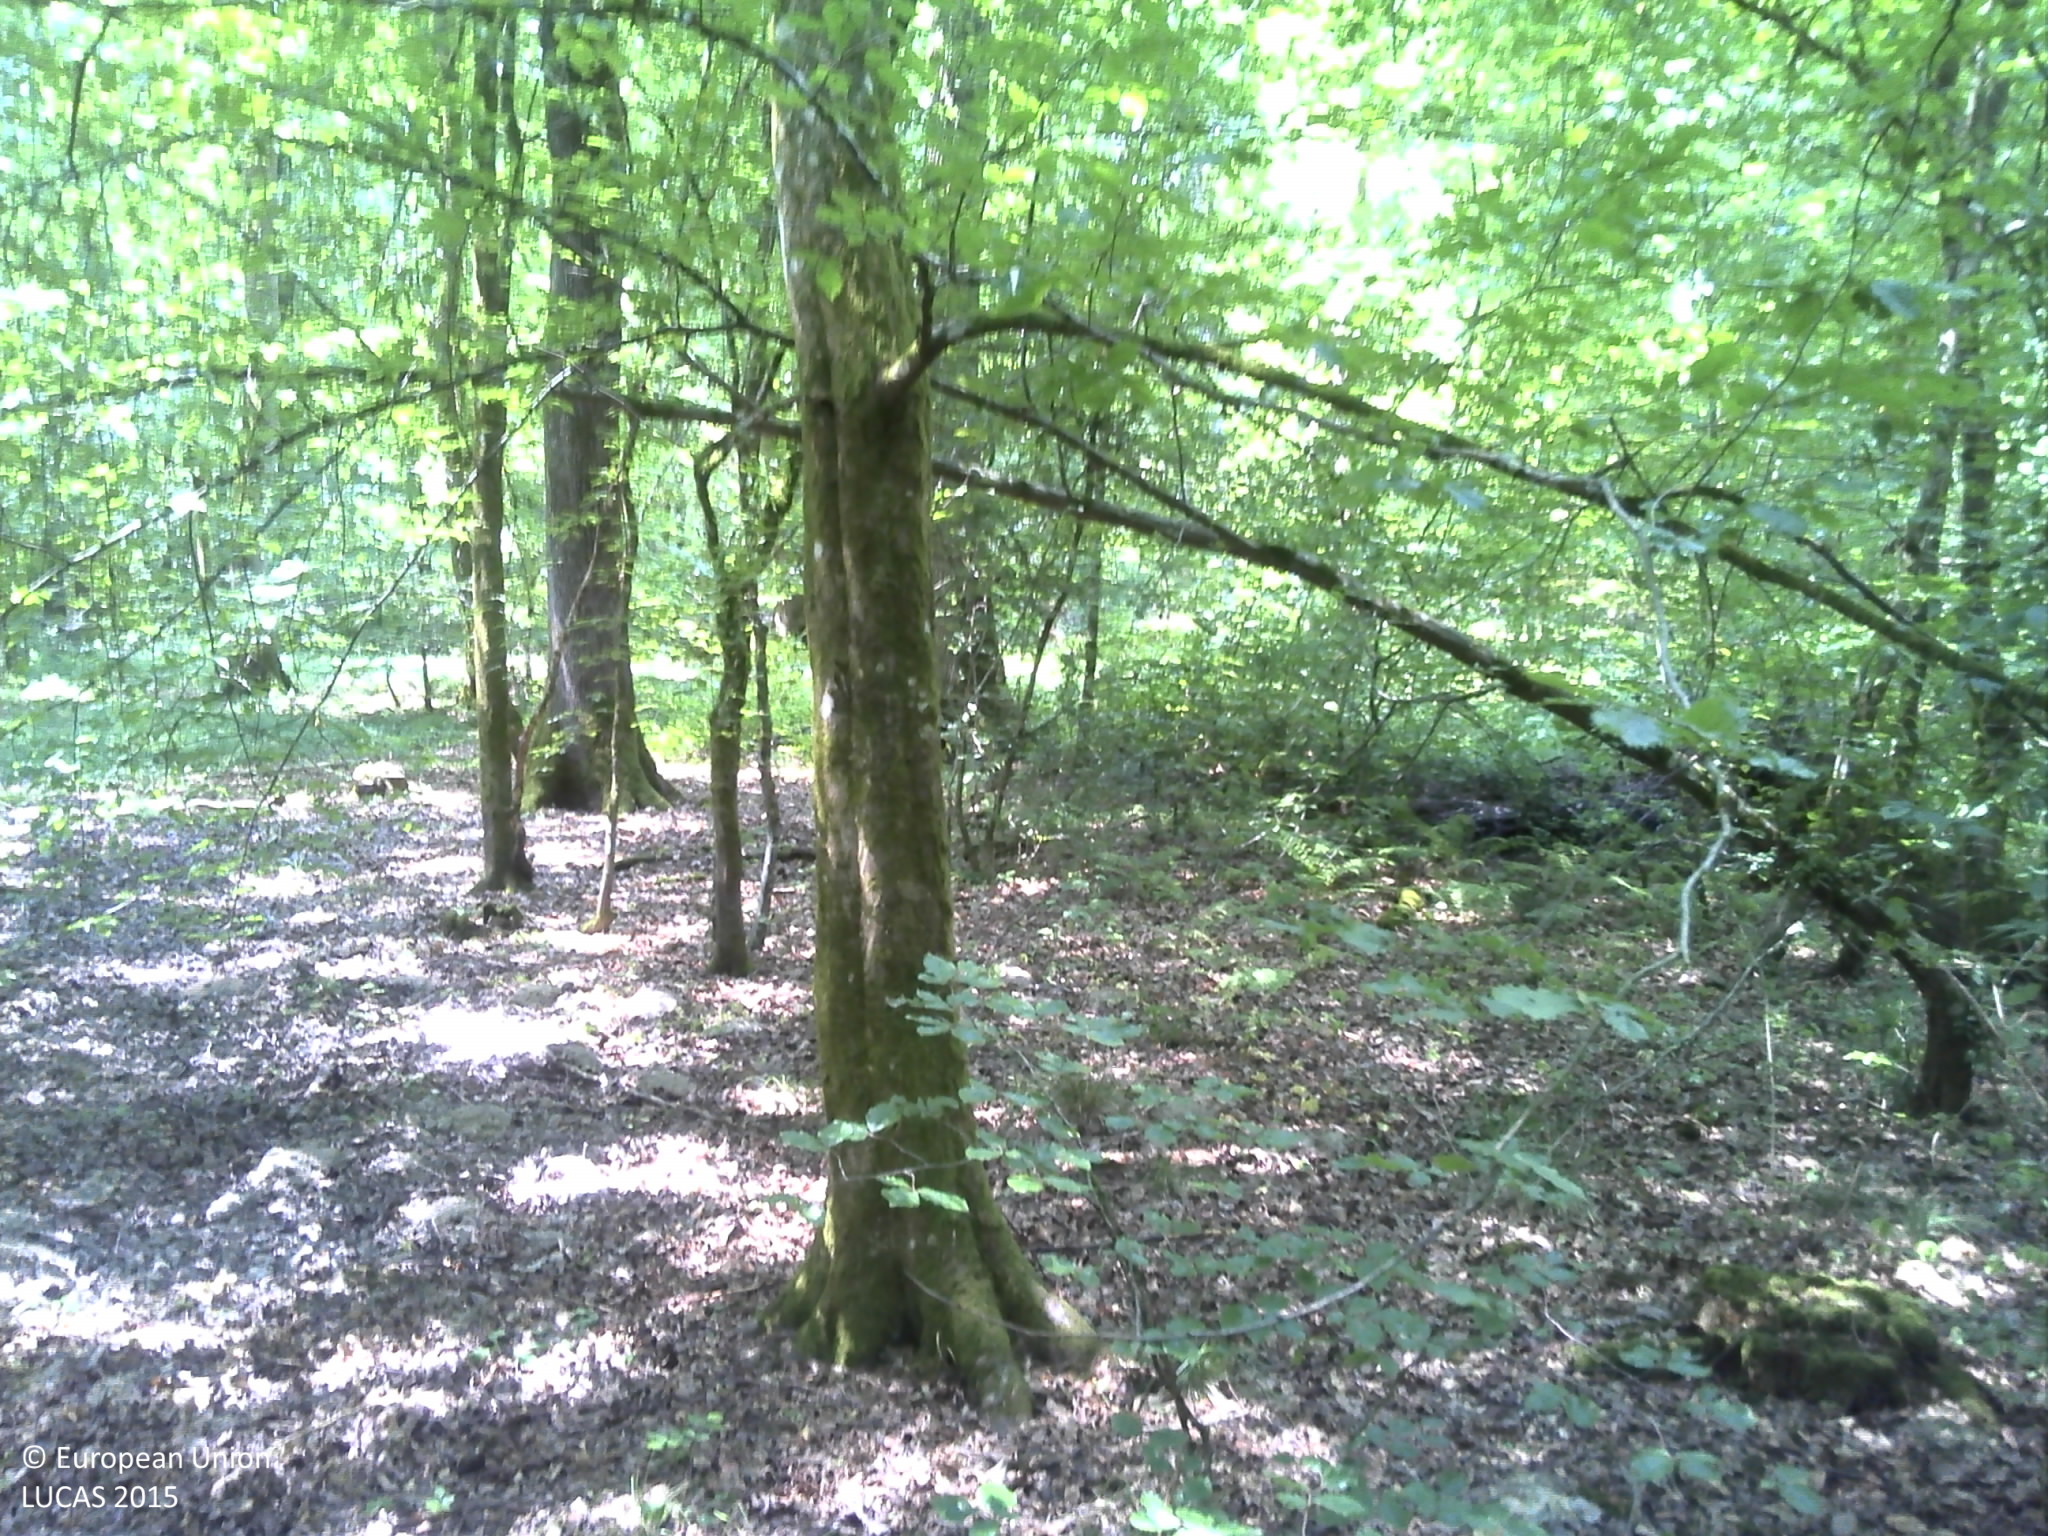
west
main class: Woodland
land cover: Broadleaved woodland
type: mesophytic deciduous forest
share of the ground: > 75 %
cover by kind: broadleaved forest trees 80 %, coniferous forest trees 20 %
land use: Forestry
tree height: > 5 m
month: July
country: FR
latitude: 49.3904
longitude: 6.4316
